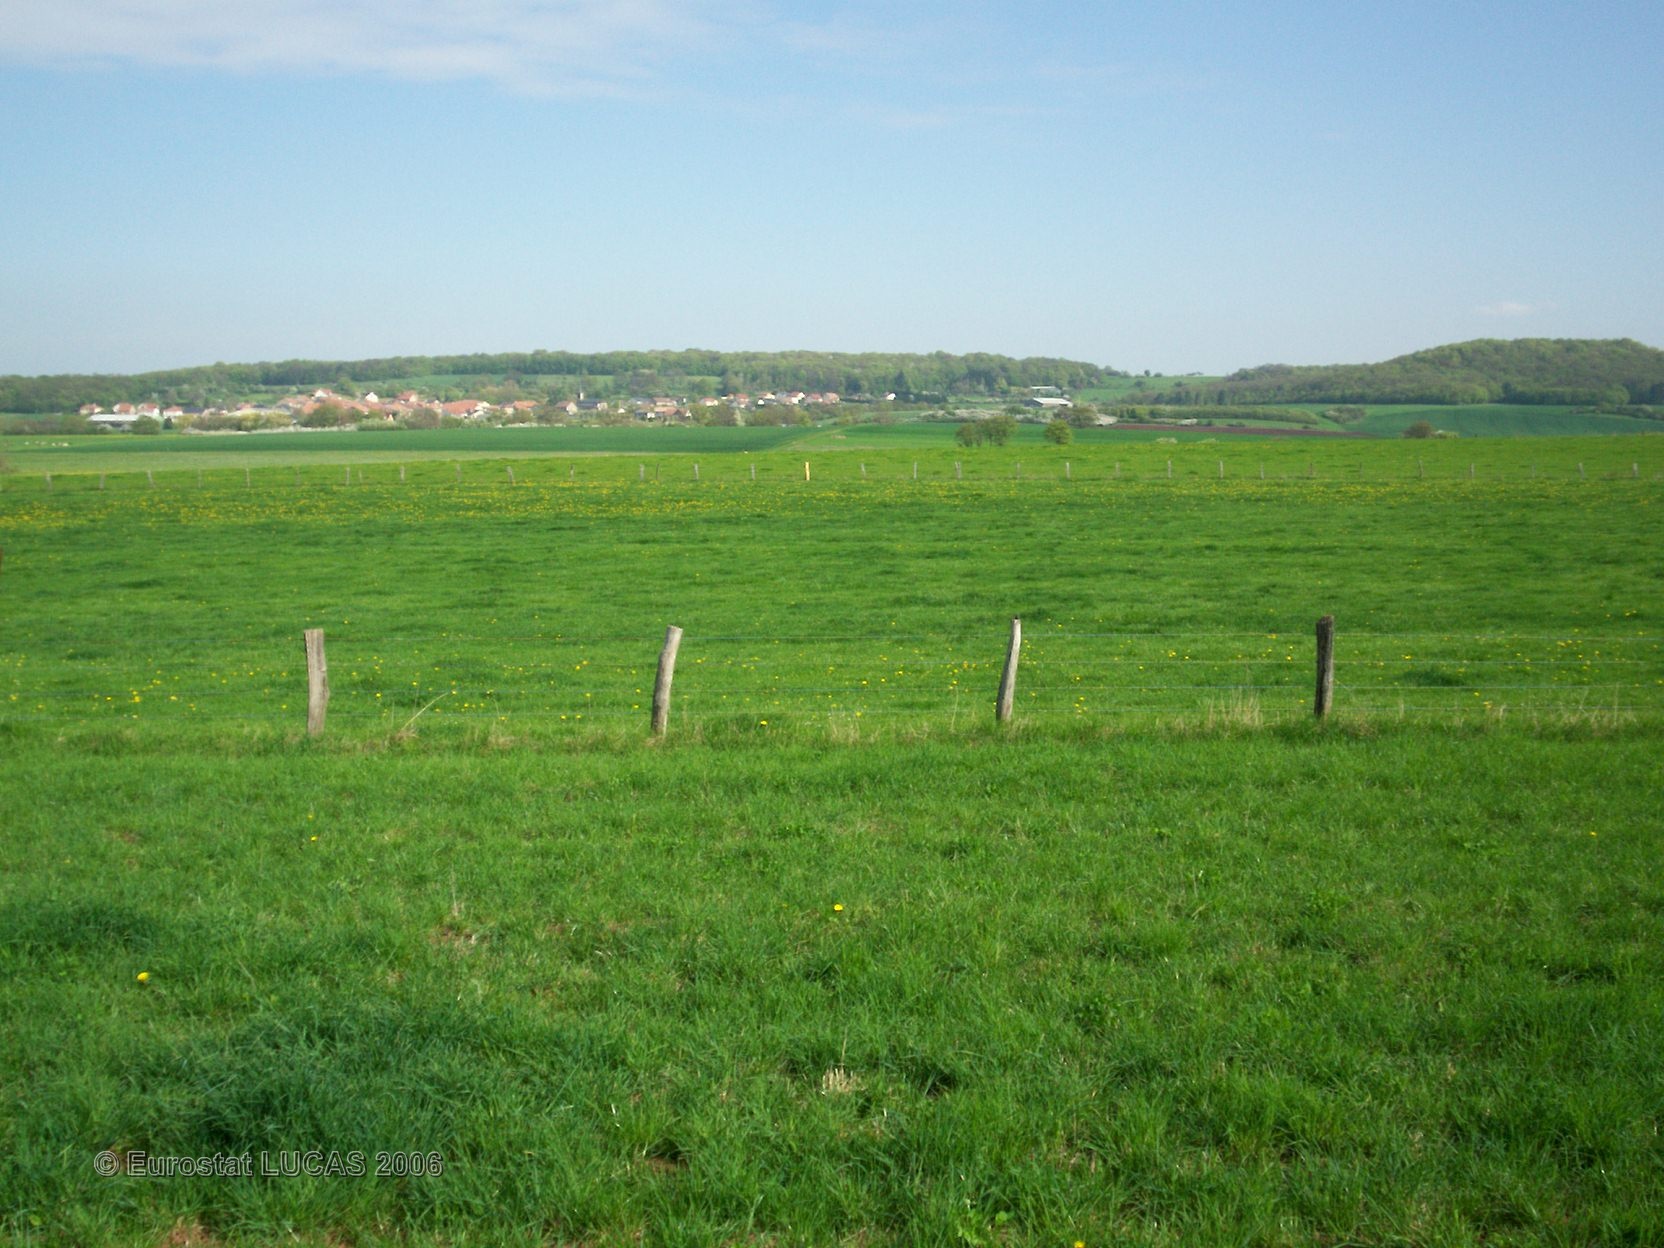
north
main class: Grassland
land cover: Grassland without tree/shrub cover
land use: Agriculture (excluding fallow land and kitchen gardens)
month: April
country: FR
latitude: 49.0050
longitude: 6.7878
